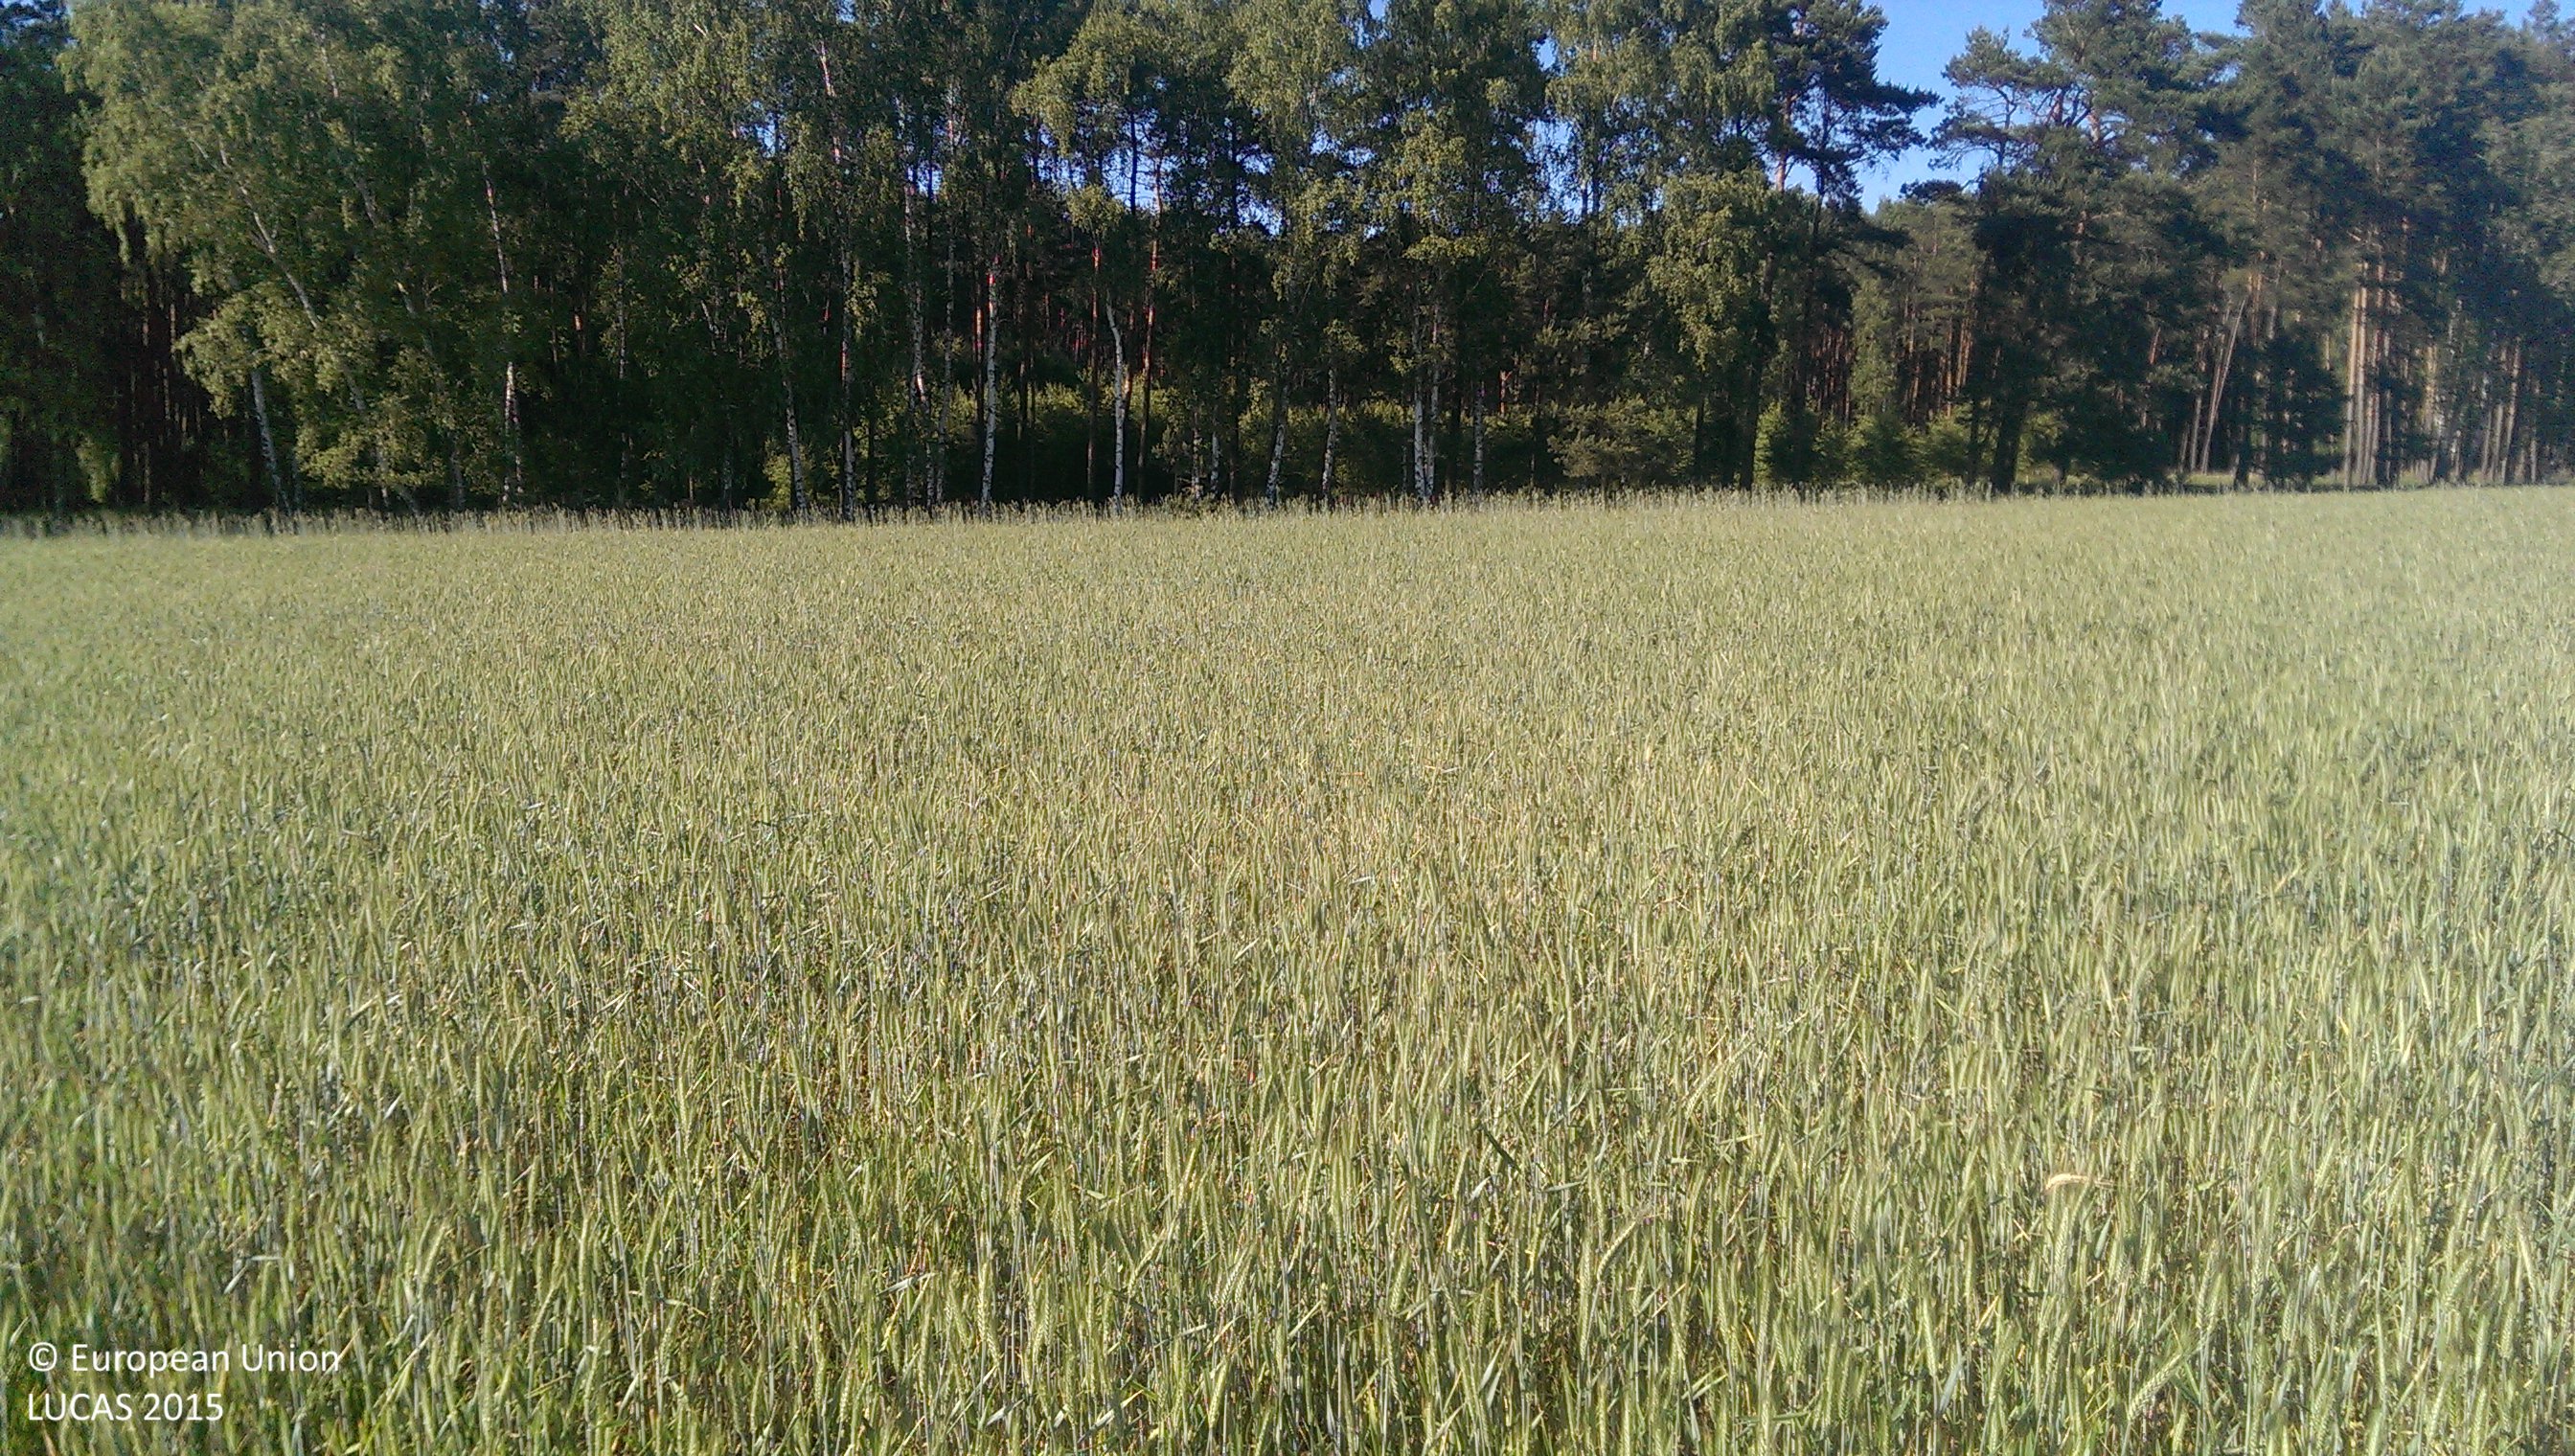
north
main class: Cropland
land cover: Triticale
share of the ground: > 75 %
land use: Agriculture (excluding fallow land and kitchen gardens)
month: June
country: PL
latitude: 51.8039
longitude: 16.1408
